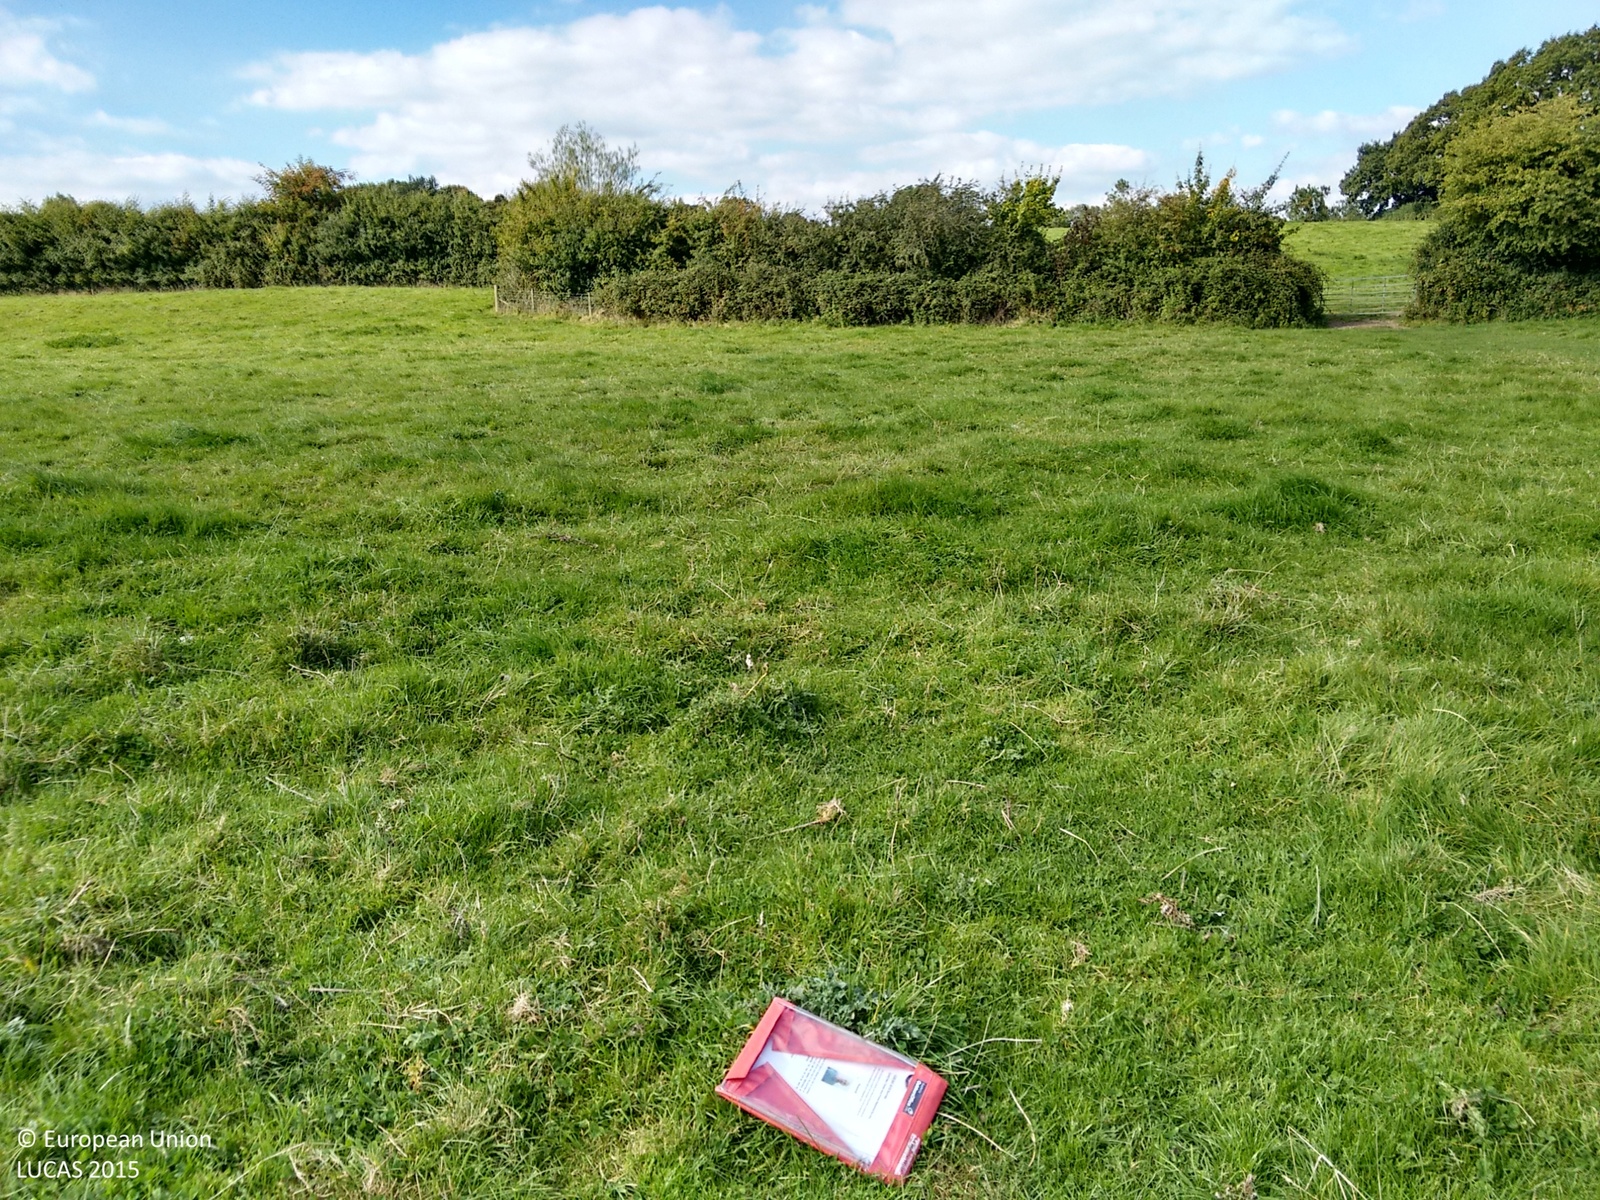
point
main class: Grassland
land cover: Grassland without tree/shrub cover
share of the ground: > 75 %
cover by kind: herbaceous plants 100 %
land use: Agriculture (excluding fallow land and kitchen gardens)
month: September
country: GB
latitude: 51.8879
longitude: -2.4004
